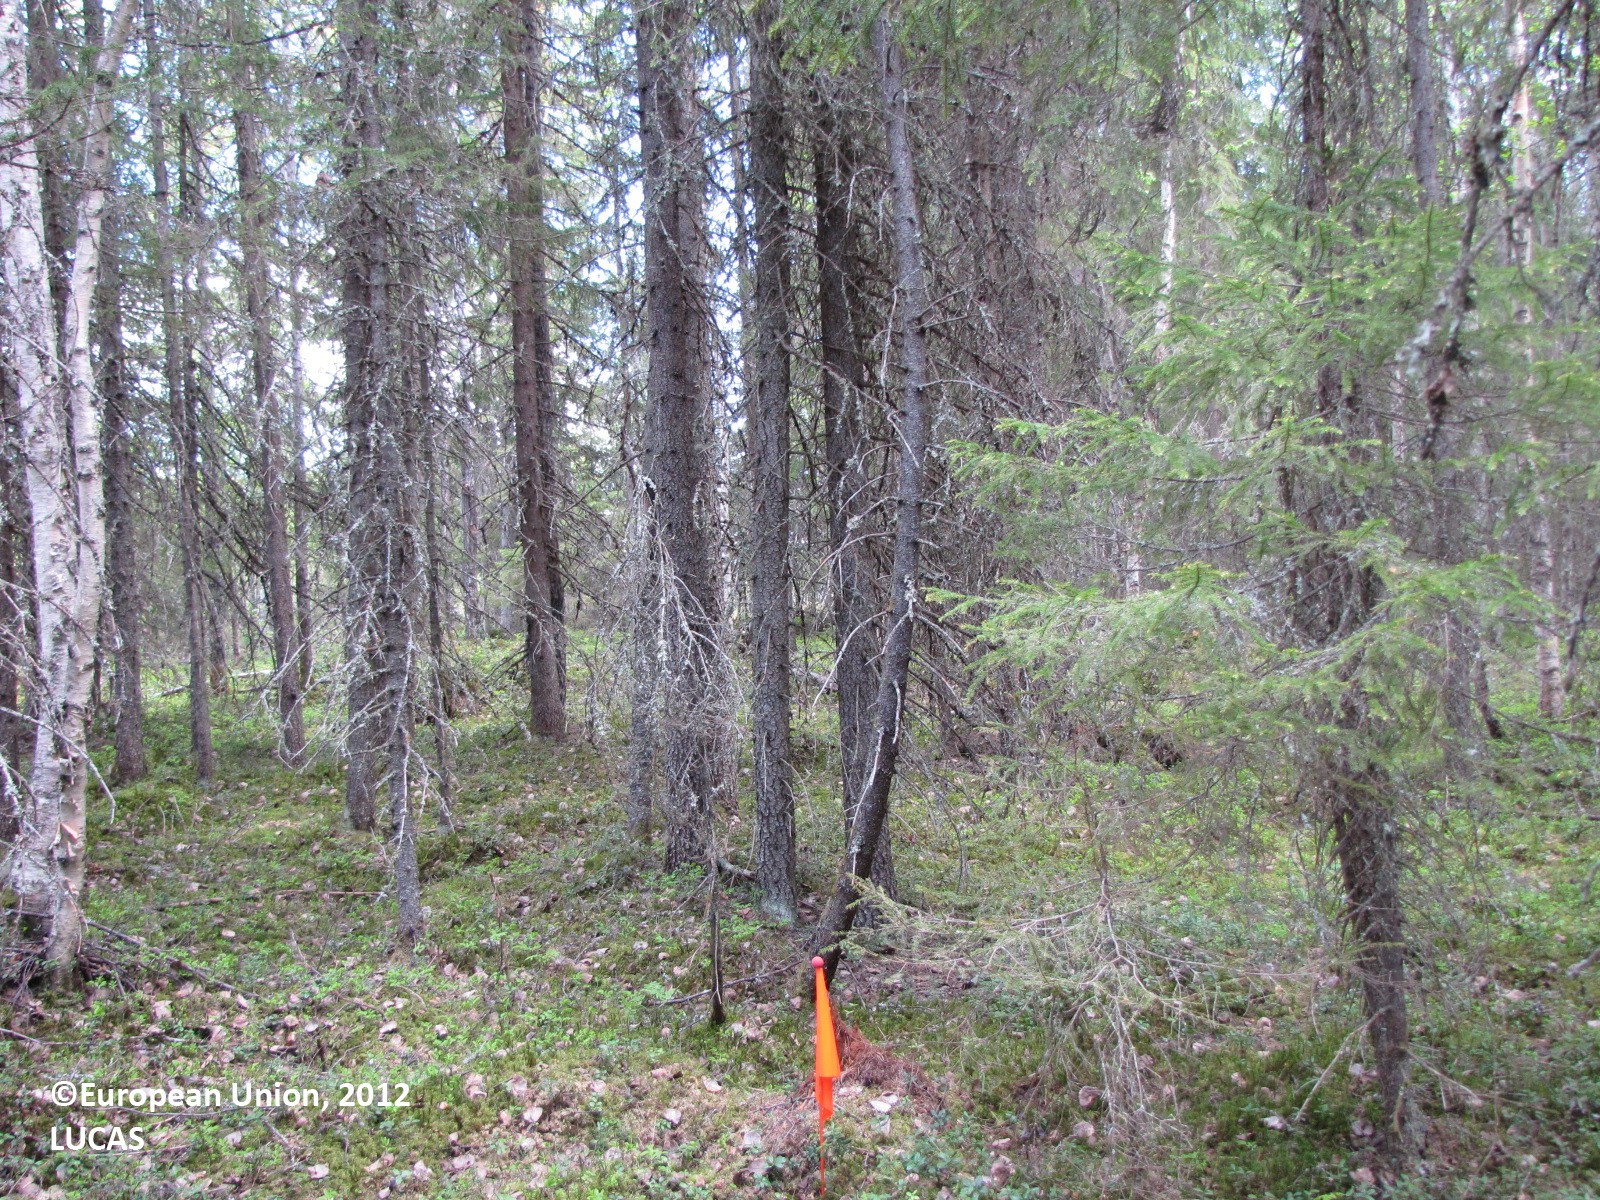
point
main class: Woodland
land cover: Spruce dominated coniferous woodland
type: boreal forest
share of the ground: 50 - 75 %
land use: Forestry
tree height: > 5 m
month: June
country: FI
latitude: 65.9908
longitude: 24.5672
